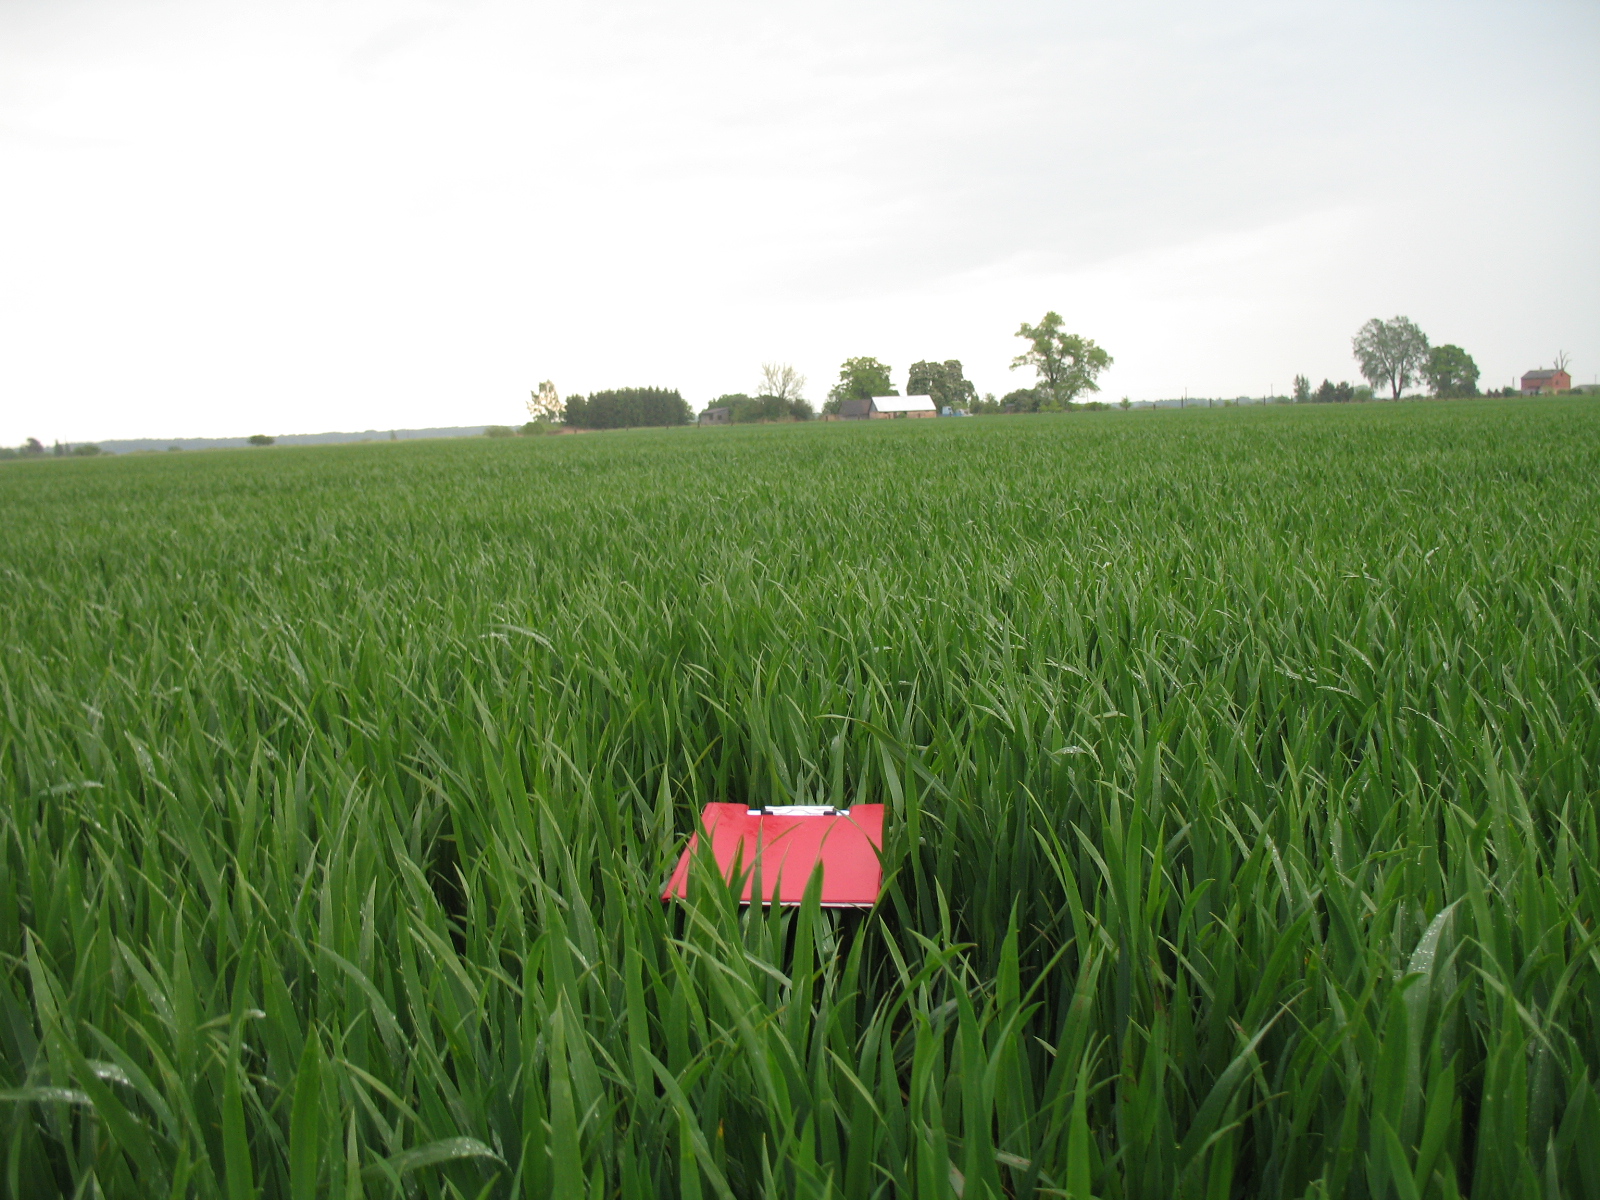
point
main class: Cropland
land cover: Common wheat
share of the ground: > 75 %
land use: Agriculture (excluding fallow land and kitchen gardens)
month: May
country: LV
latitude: 56.7308
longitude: 23.4930
